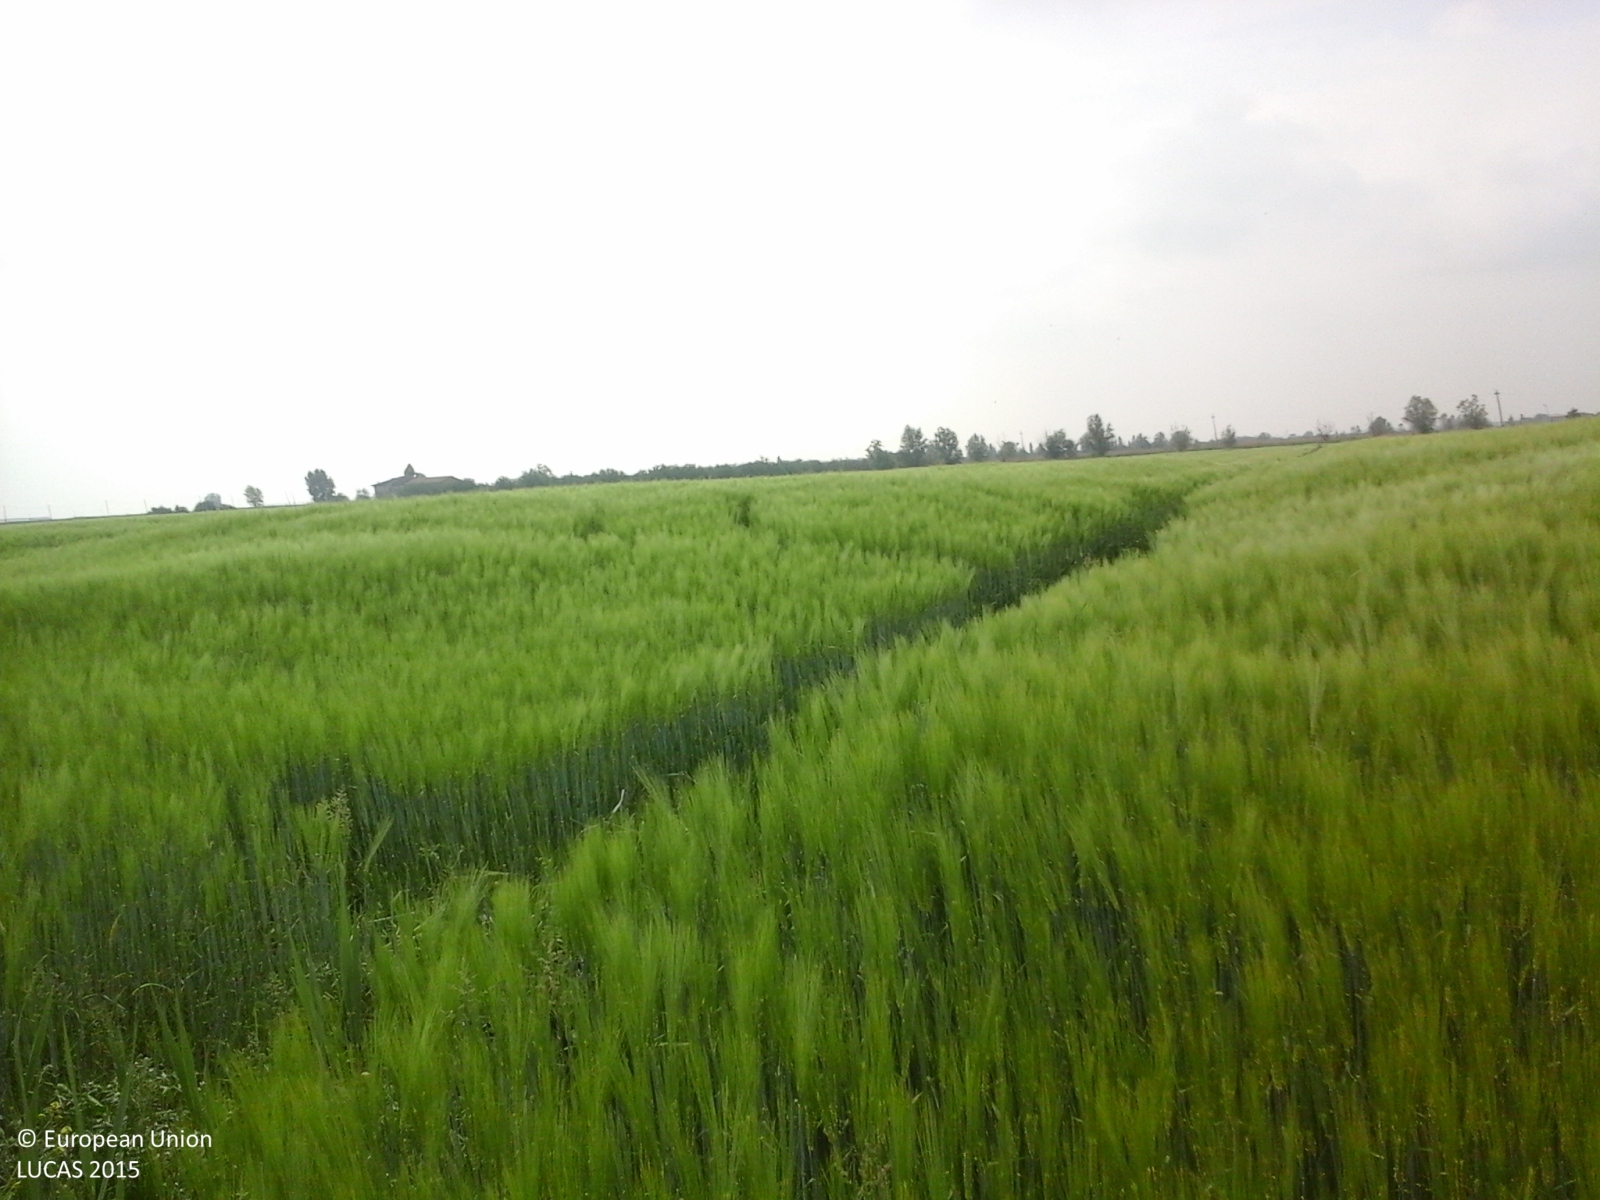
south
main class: Cropland
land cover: Durum wheat
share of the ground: > 75 %
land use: Agriculture (excluding fallow land and kitchen gardens)
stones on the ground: < 10 %
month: May
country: IT
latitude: 44.9024
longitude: 11.2260
